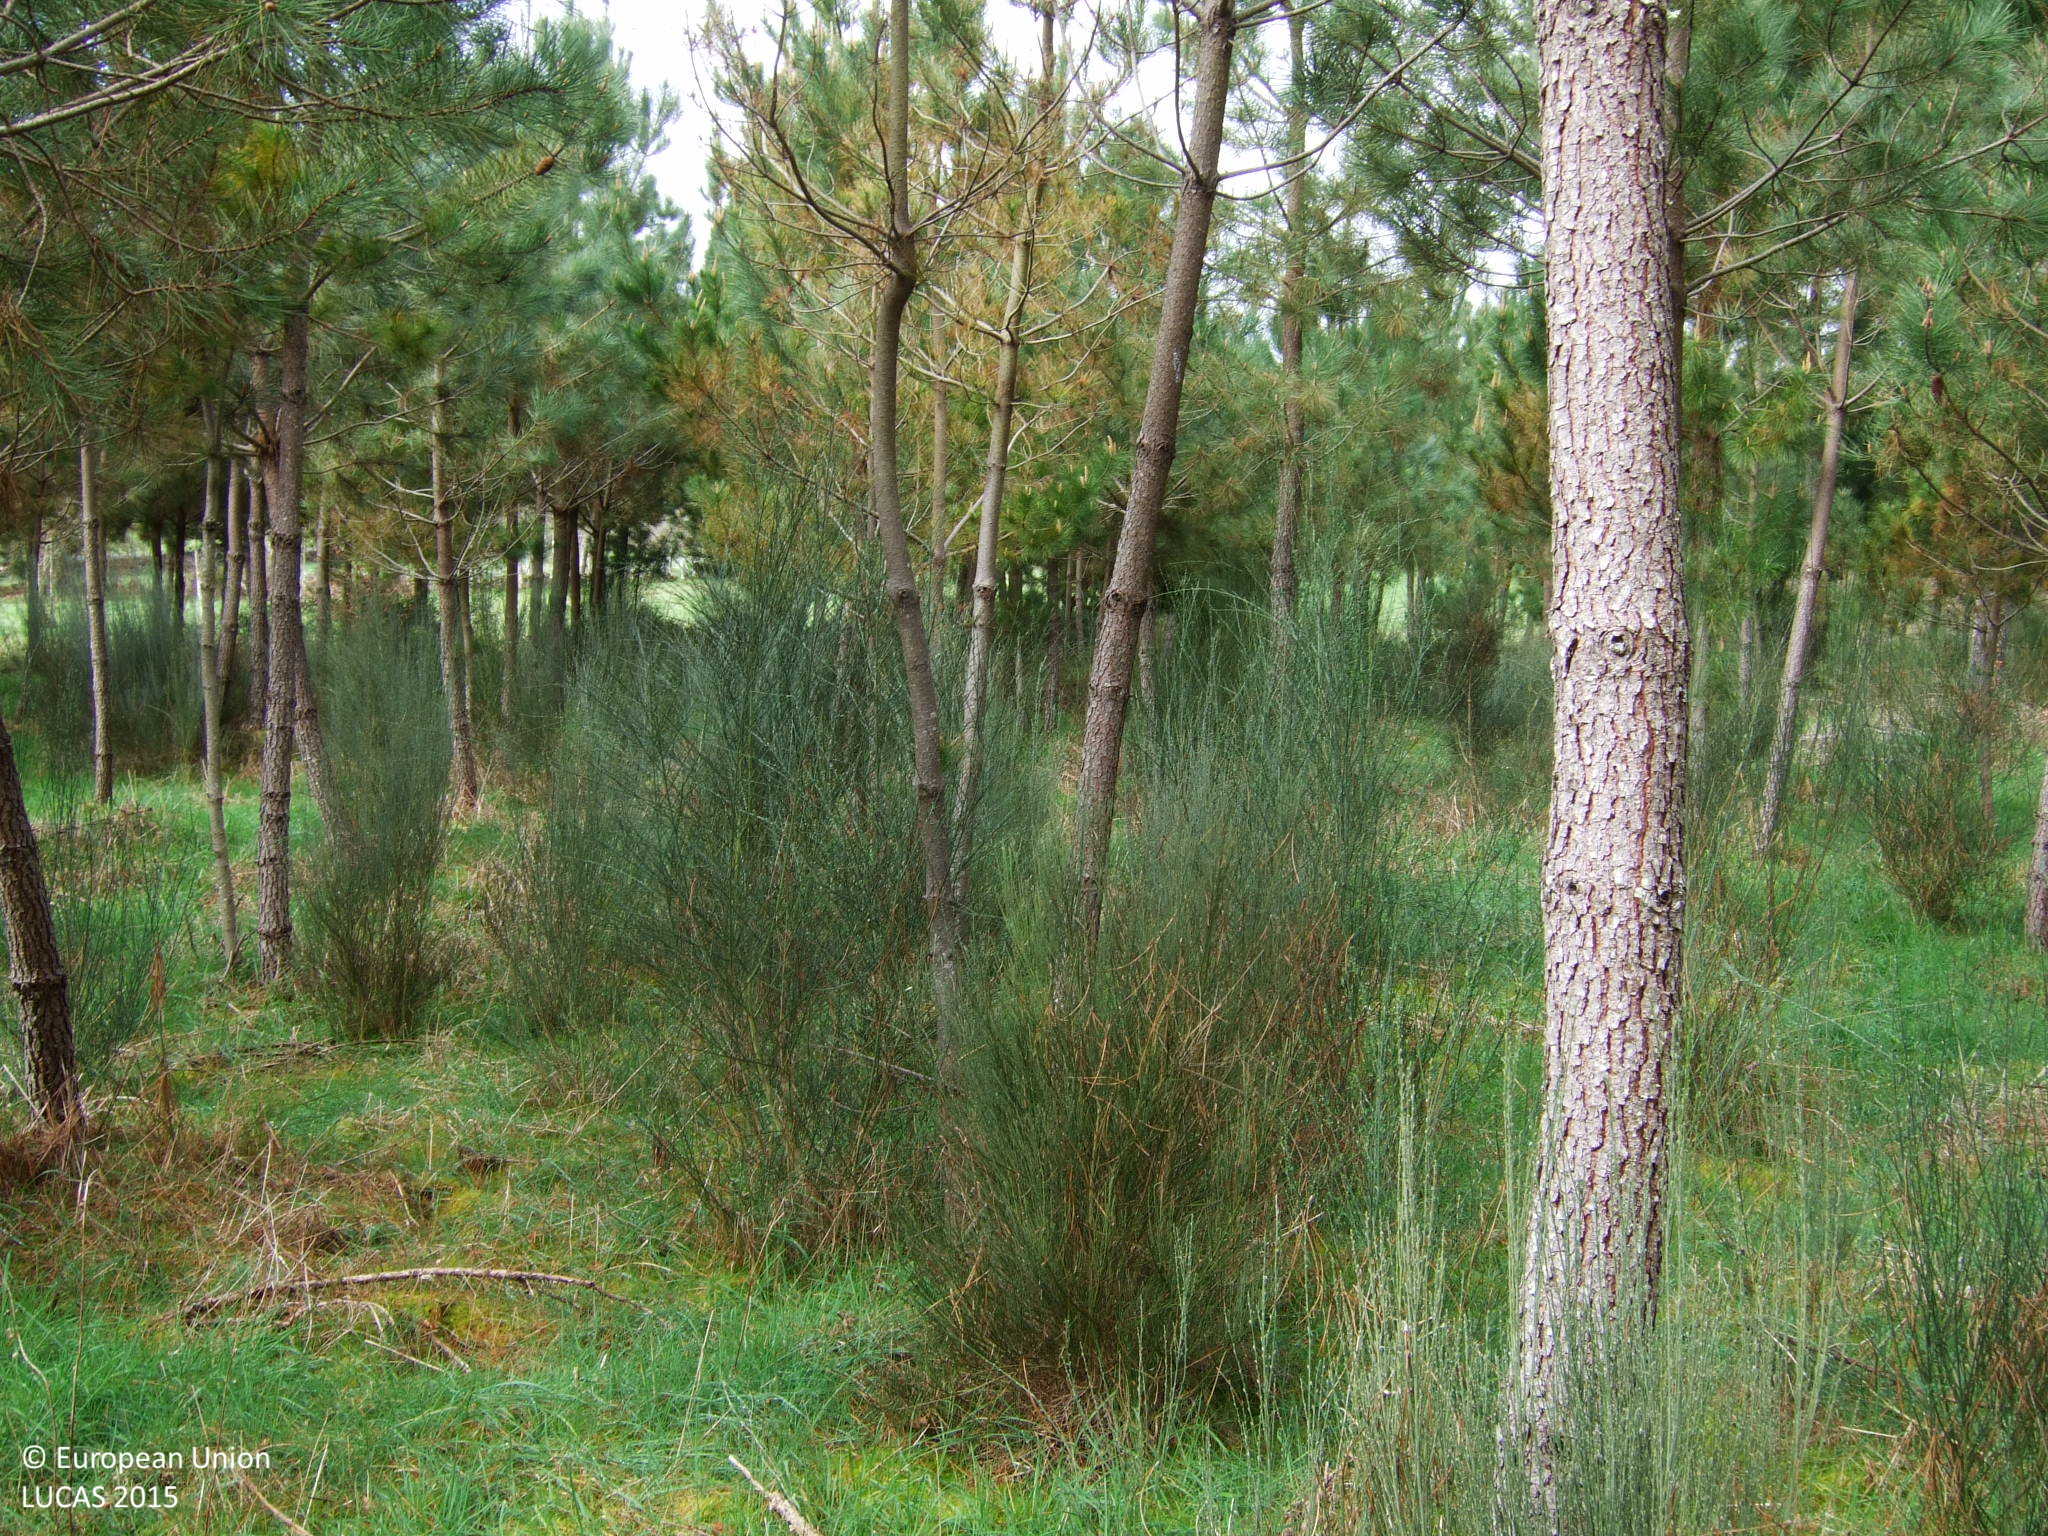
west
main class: Woodland
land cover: Pine dominated coniferous woodland
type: exotic forest
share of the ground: > 75 %
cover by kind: coniferous forest trees 80 %, shrubs 10 %, herbaceous plants 10 %
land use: Forestry
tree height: > 5 m
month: March
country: ES
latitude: 42.8099
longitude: -7.8267
